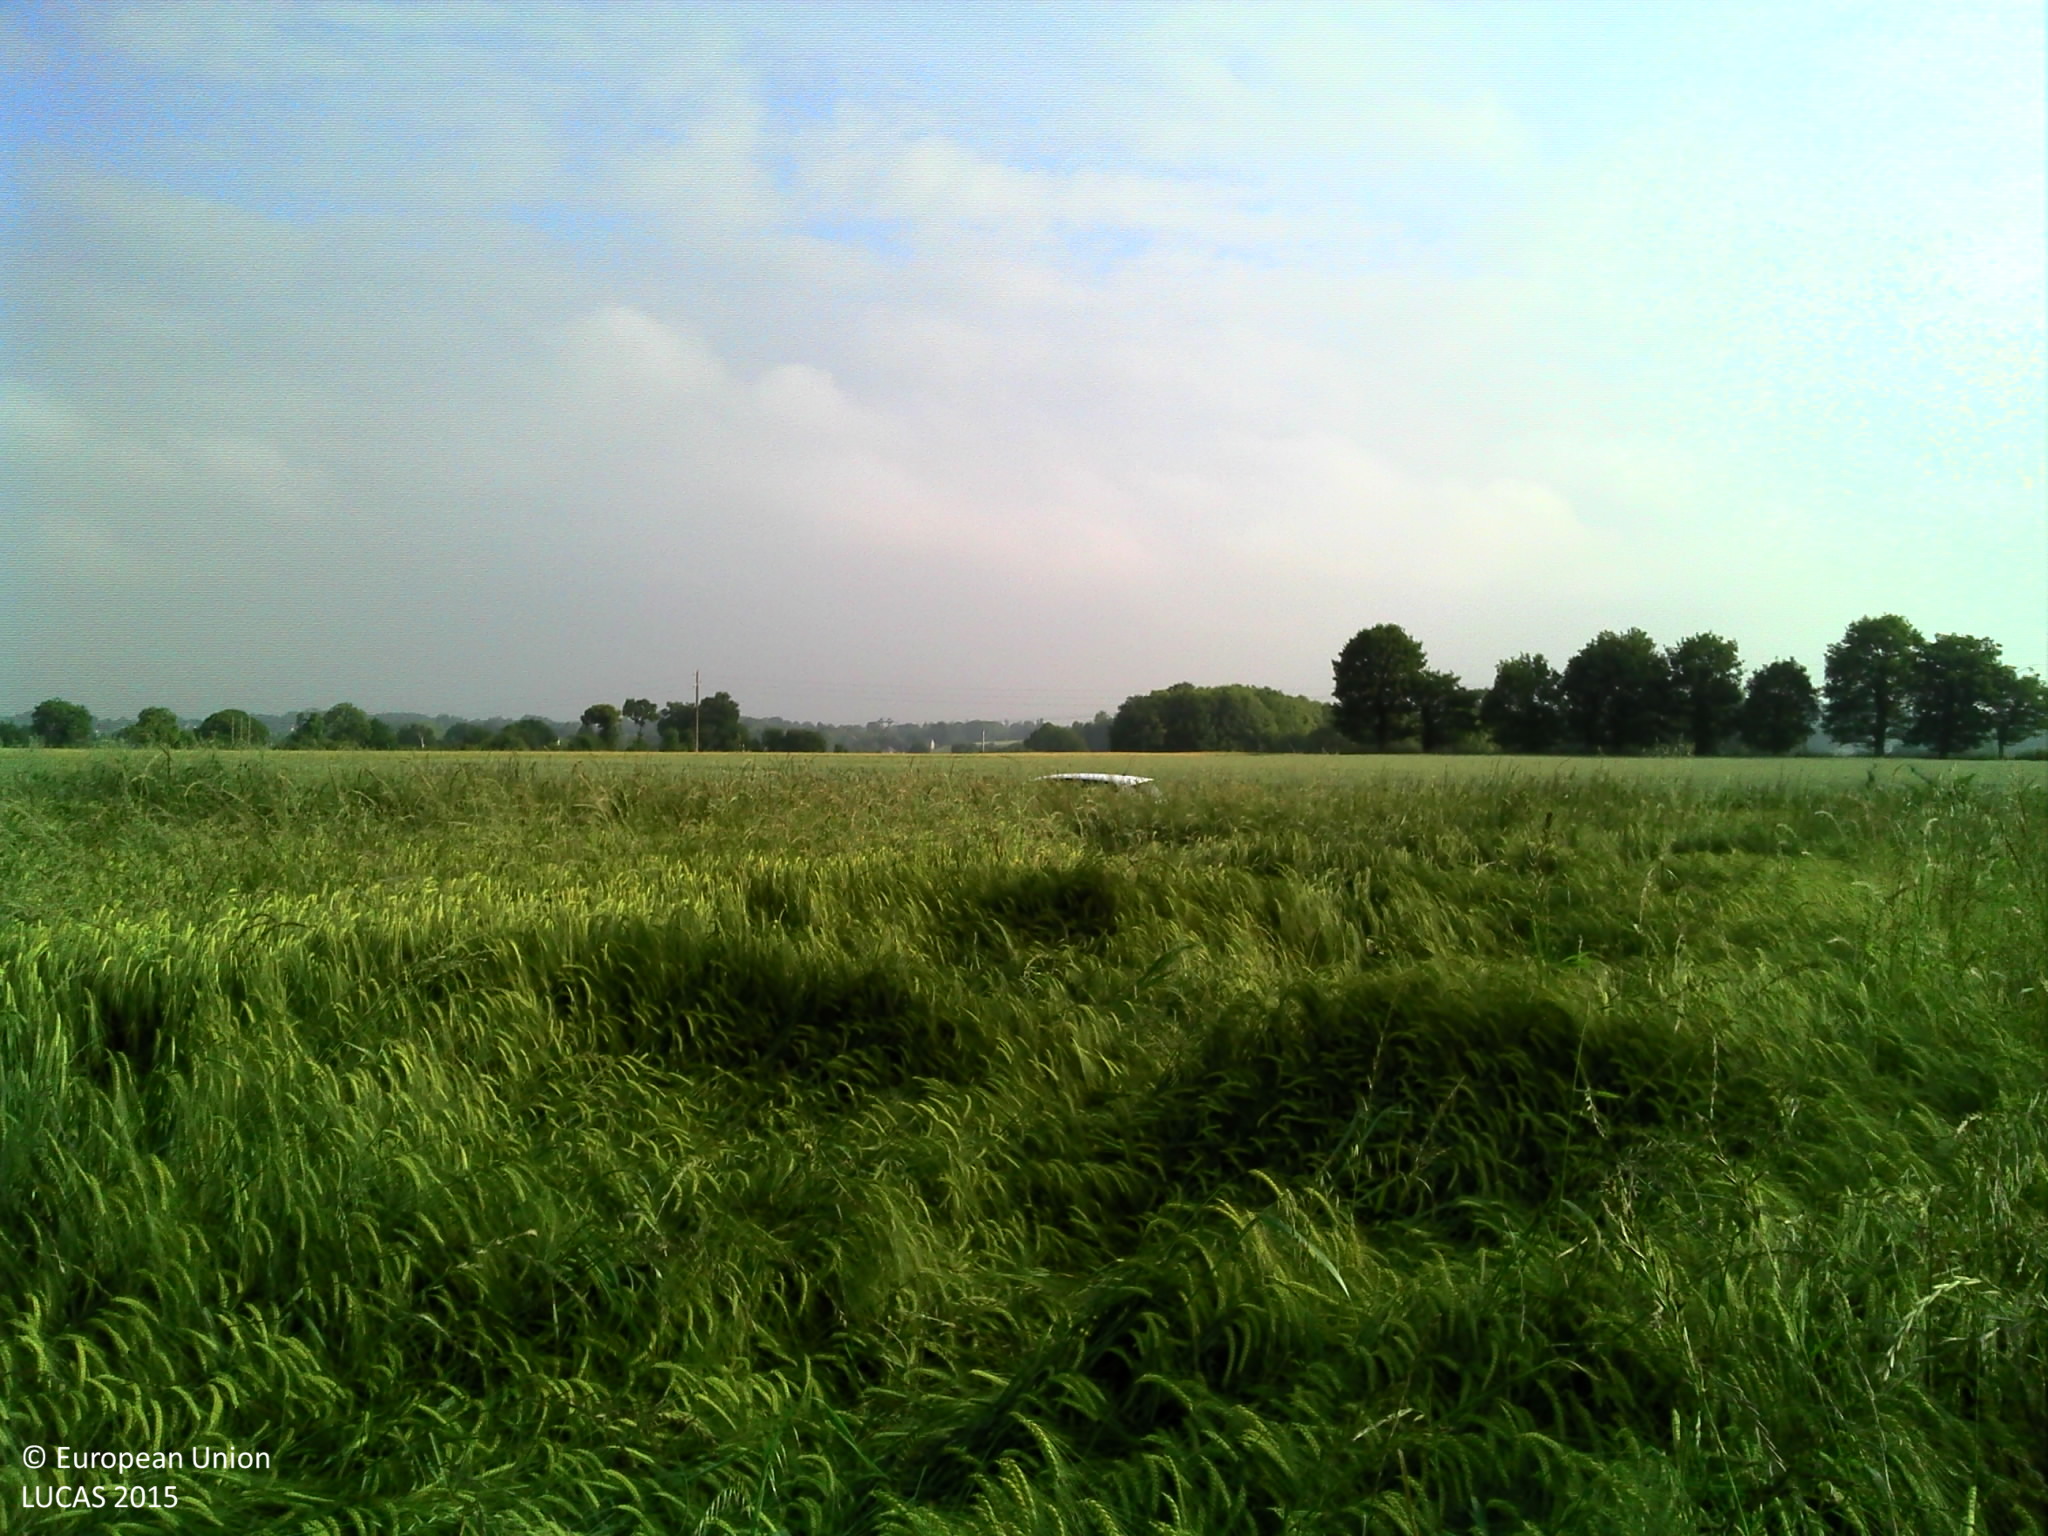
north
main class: Cropland
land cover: Barley
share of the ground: > 75 %
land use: Agriculture (excluding fallow land and kitchen gardens)
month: June
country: FR
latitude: 48.4151
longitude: -1.7098
